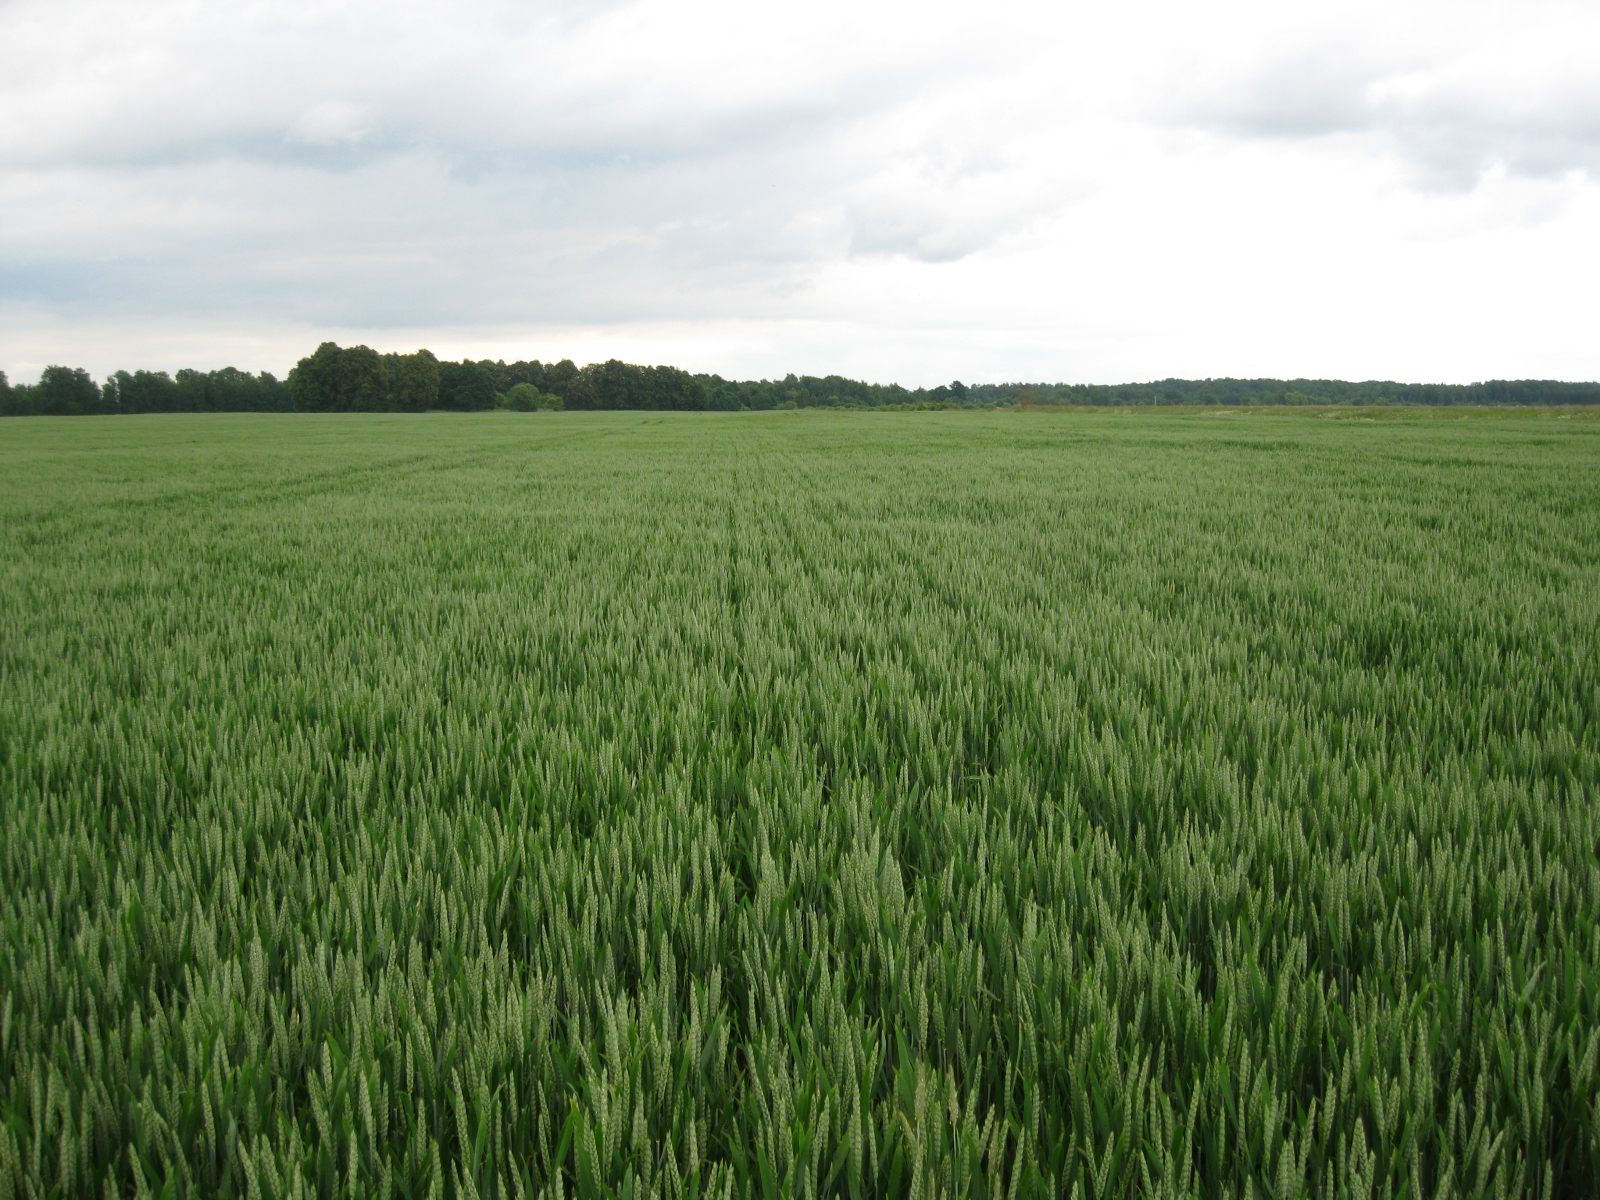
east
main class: Cropland
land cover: Common wheat
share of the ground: > 75 %
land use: Agriculture (excluding fallow land and kitchen gardens)
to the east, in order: Common wheat
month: June
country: LT
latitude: 55.2035
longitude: 24.0921
